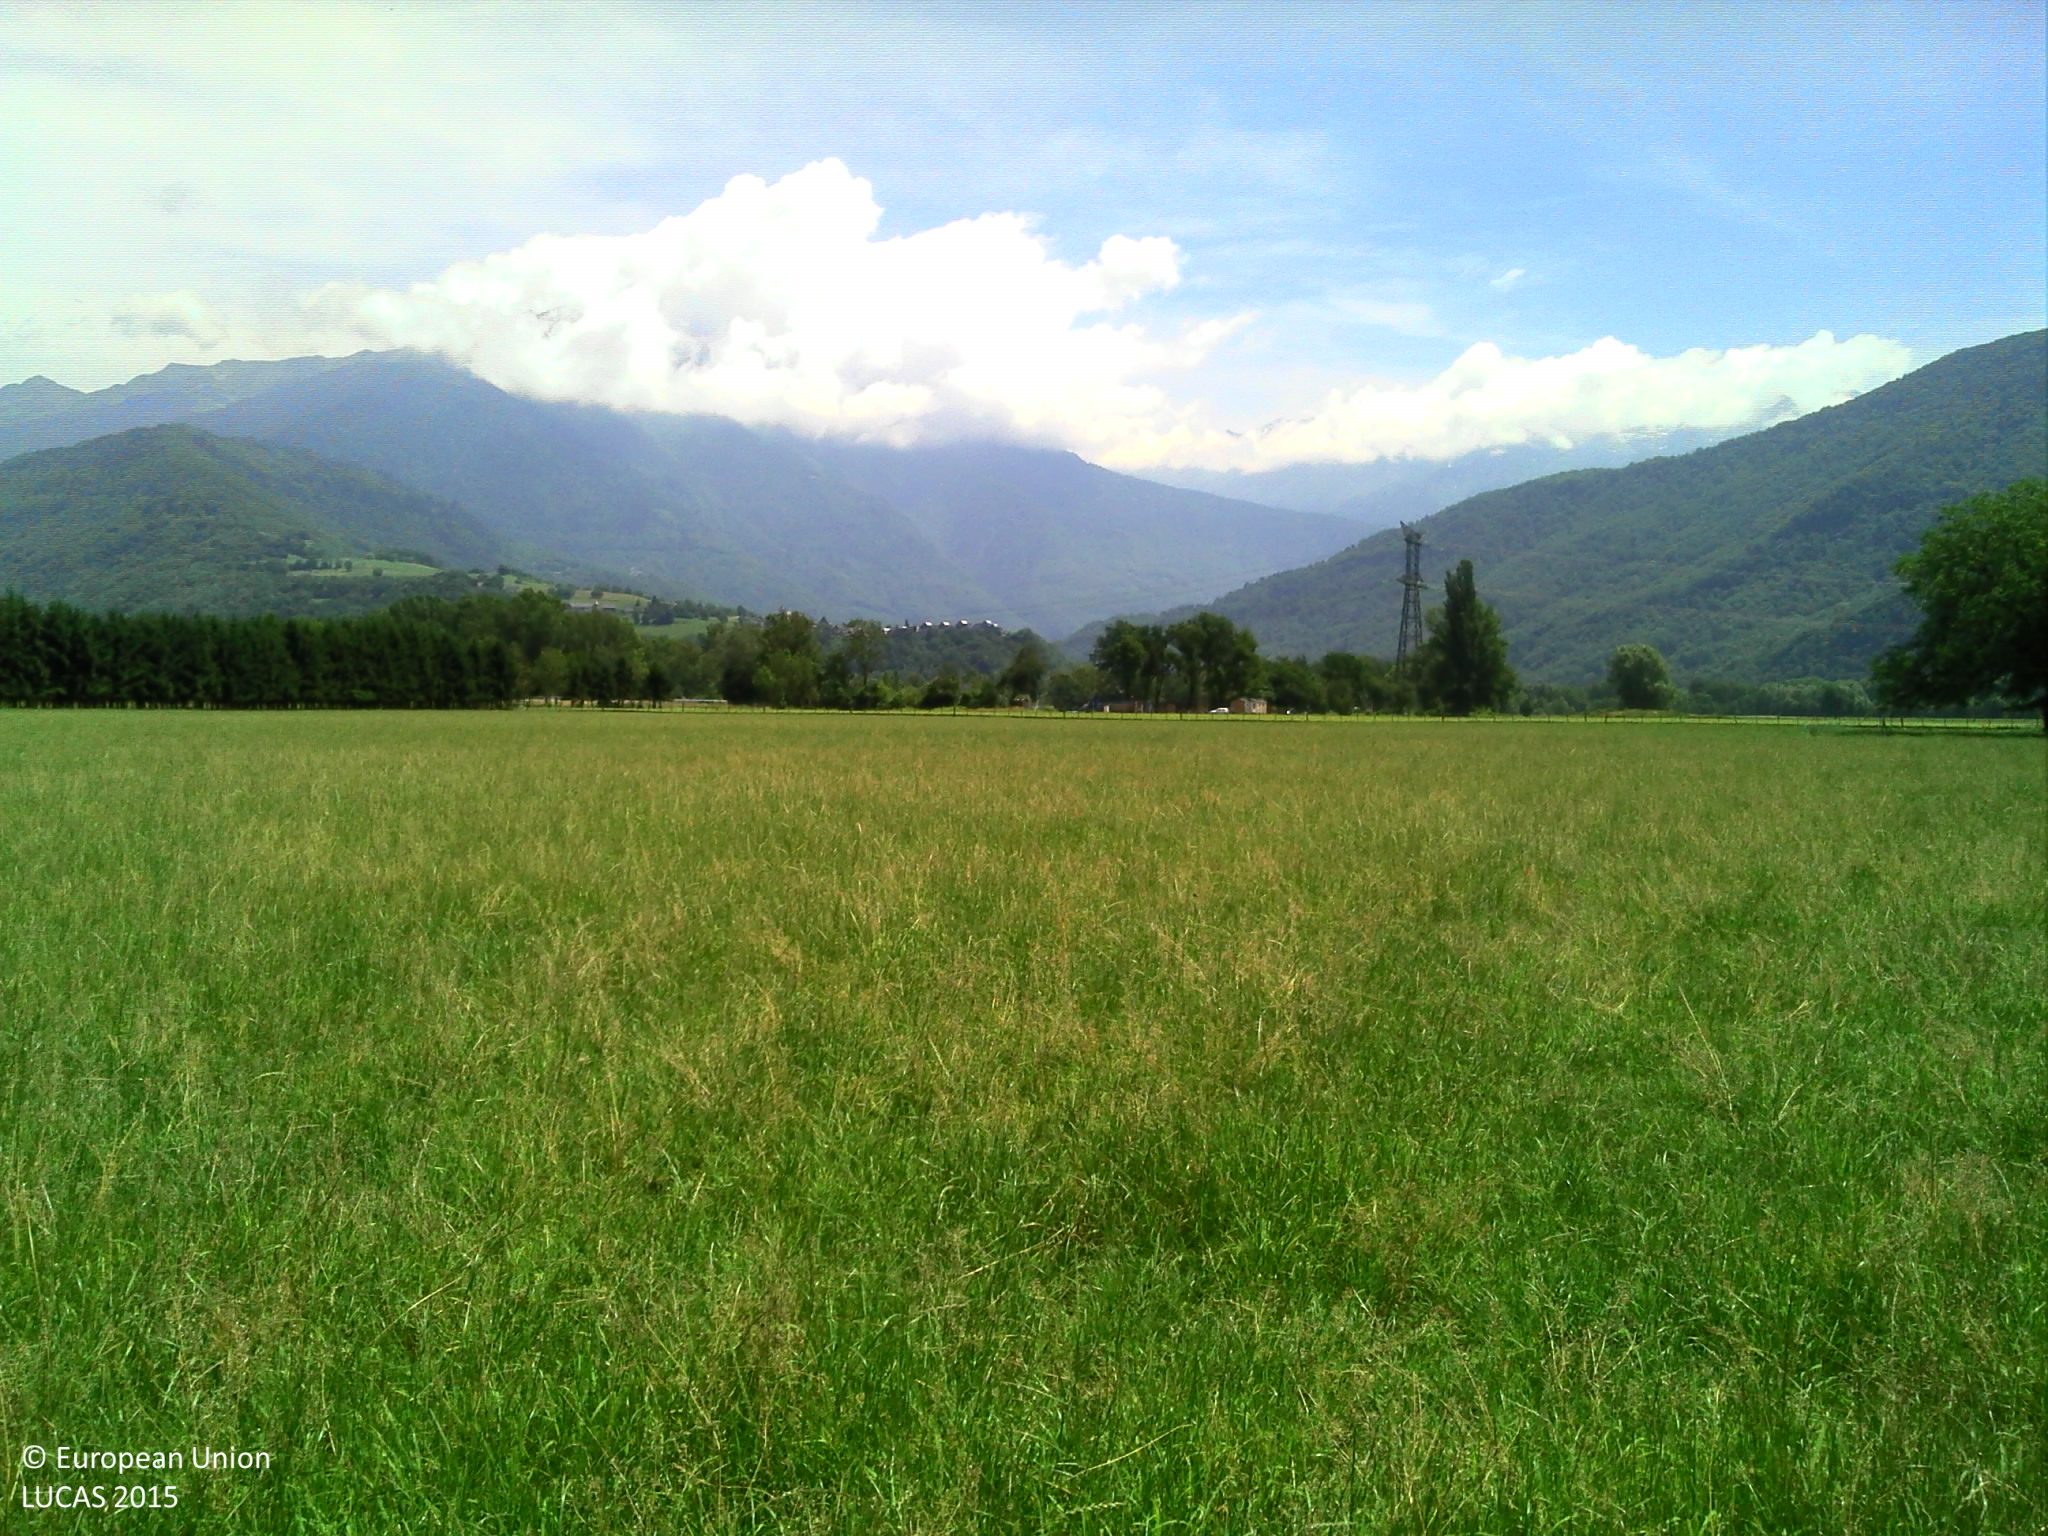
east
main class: Grassland
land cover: Grassland without tree/shrub cover
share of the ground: > 75 %
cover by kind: herbaceous plants 100 %
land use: Agriculture (excluding fallow land and kitchen gardens)
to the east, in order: Grassland without tree/shrub cover
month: June
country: FR
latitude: 45.5632
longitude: 6.2250
